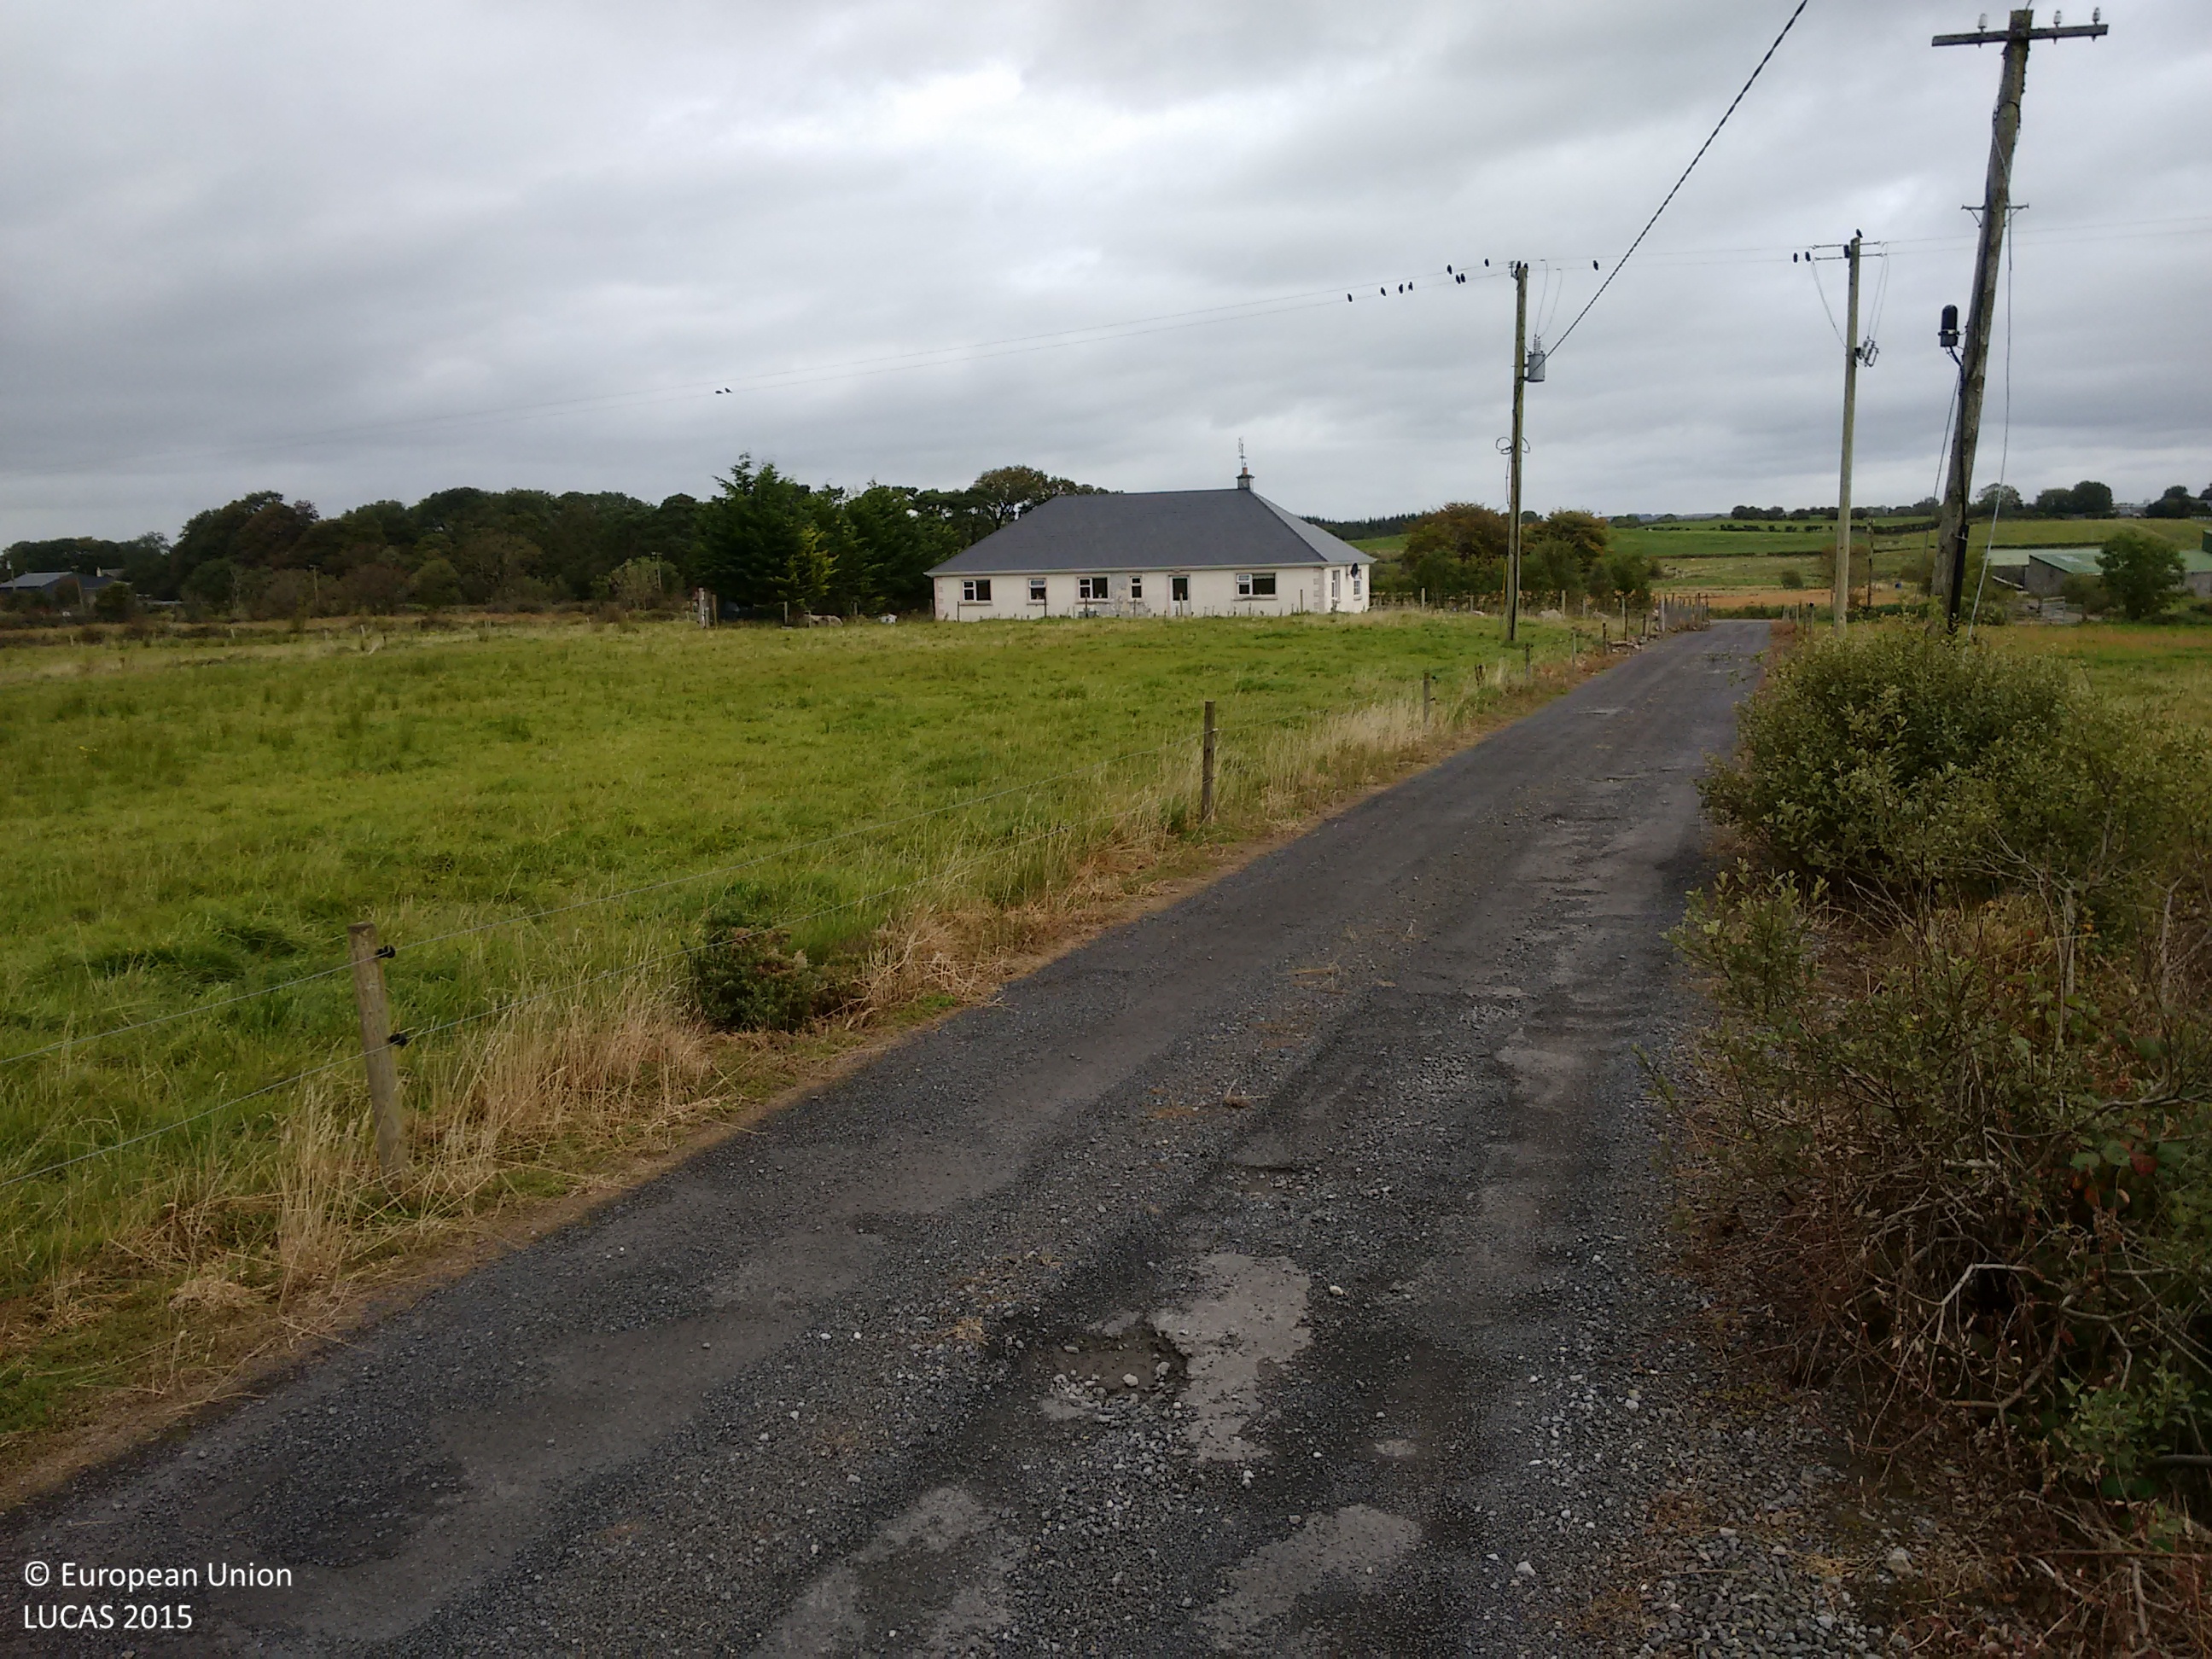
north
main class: Grassland
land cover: Grassland without tree/shrub cover
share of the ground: > 75 %
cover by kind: herbaceous plants 100 %
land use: Agriculture (excluding fallow land and kitchen gardens)
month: September
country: IE
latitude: 53.8386
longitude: -8.8843
